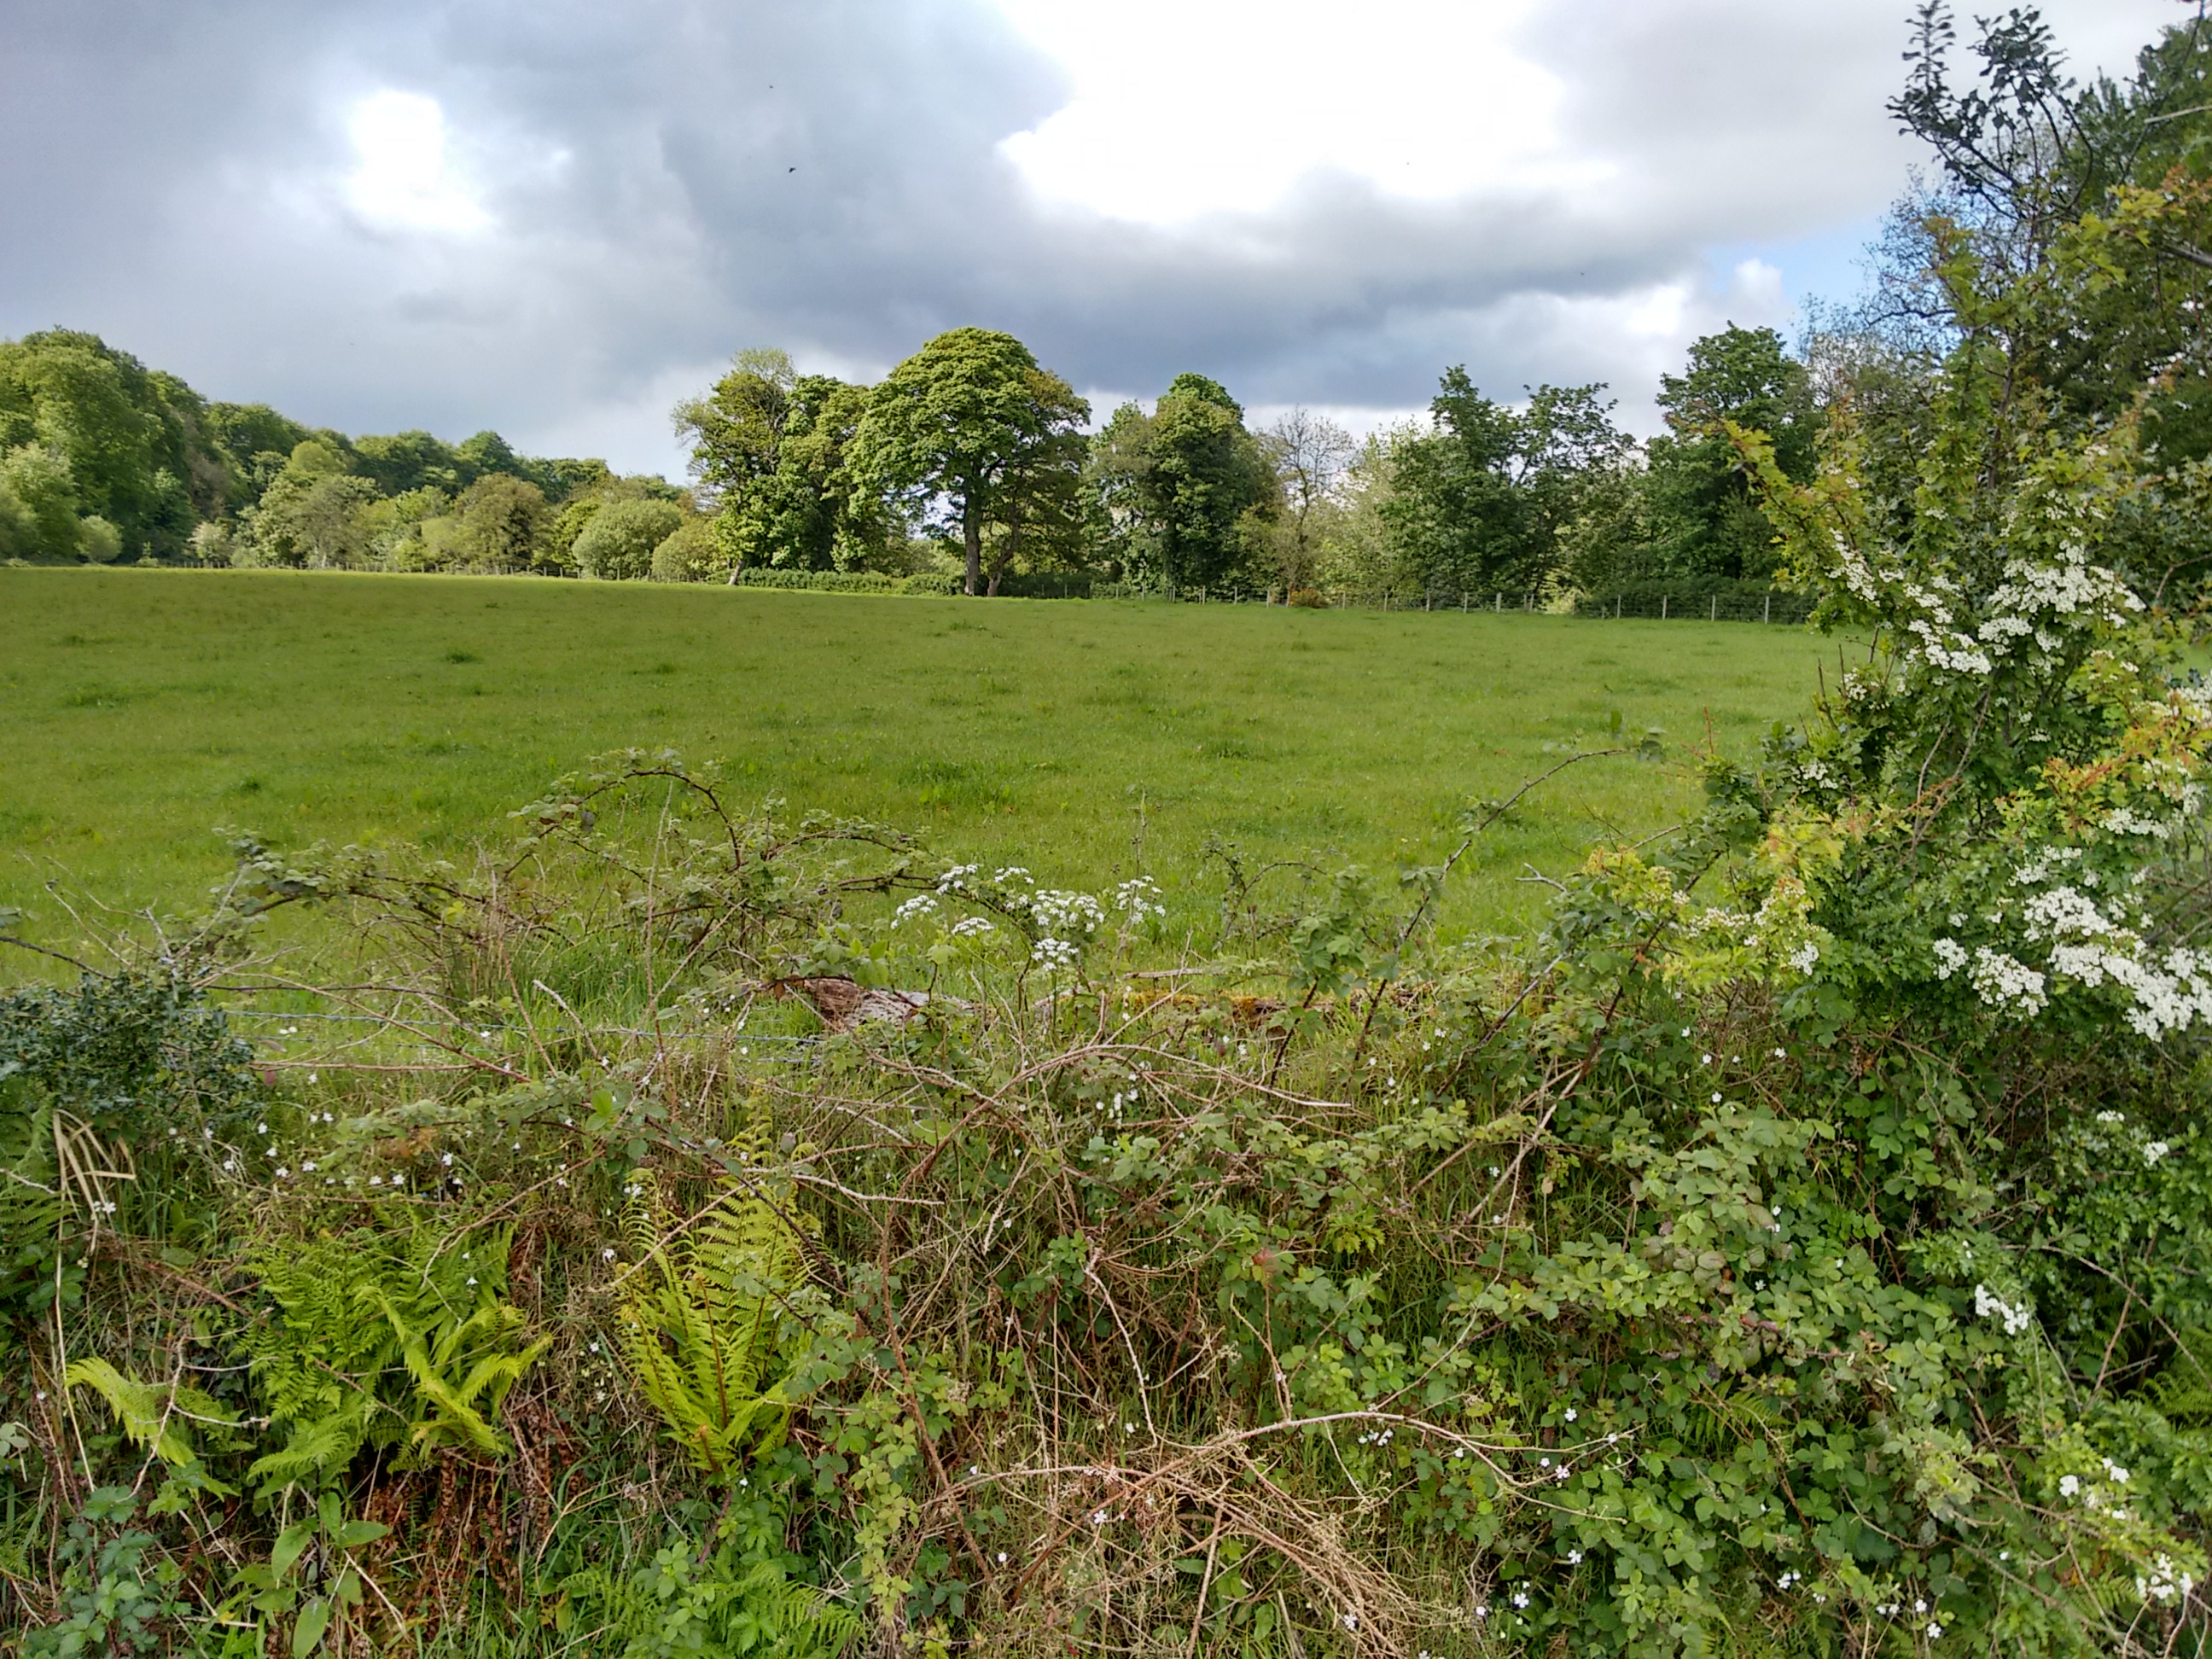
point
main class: Grassland
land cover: Grassland without tree/shrub cover
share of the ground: > 75 %
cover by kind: herbaceous plants 100 %
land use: Agriculture (excluding fallow land and kitchen gardens)
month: May
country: GB
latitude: 54.9513
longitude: -7.2432
